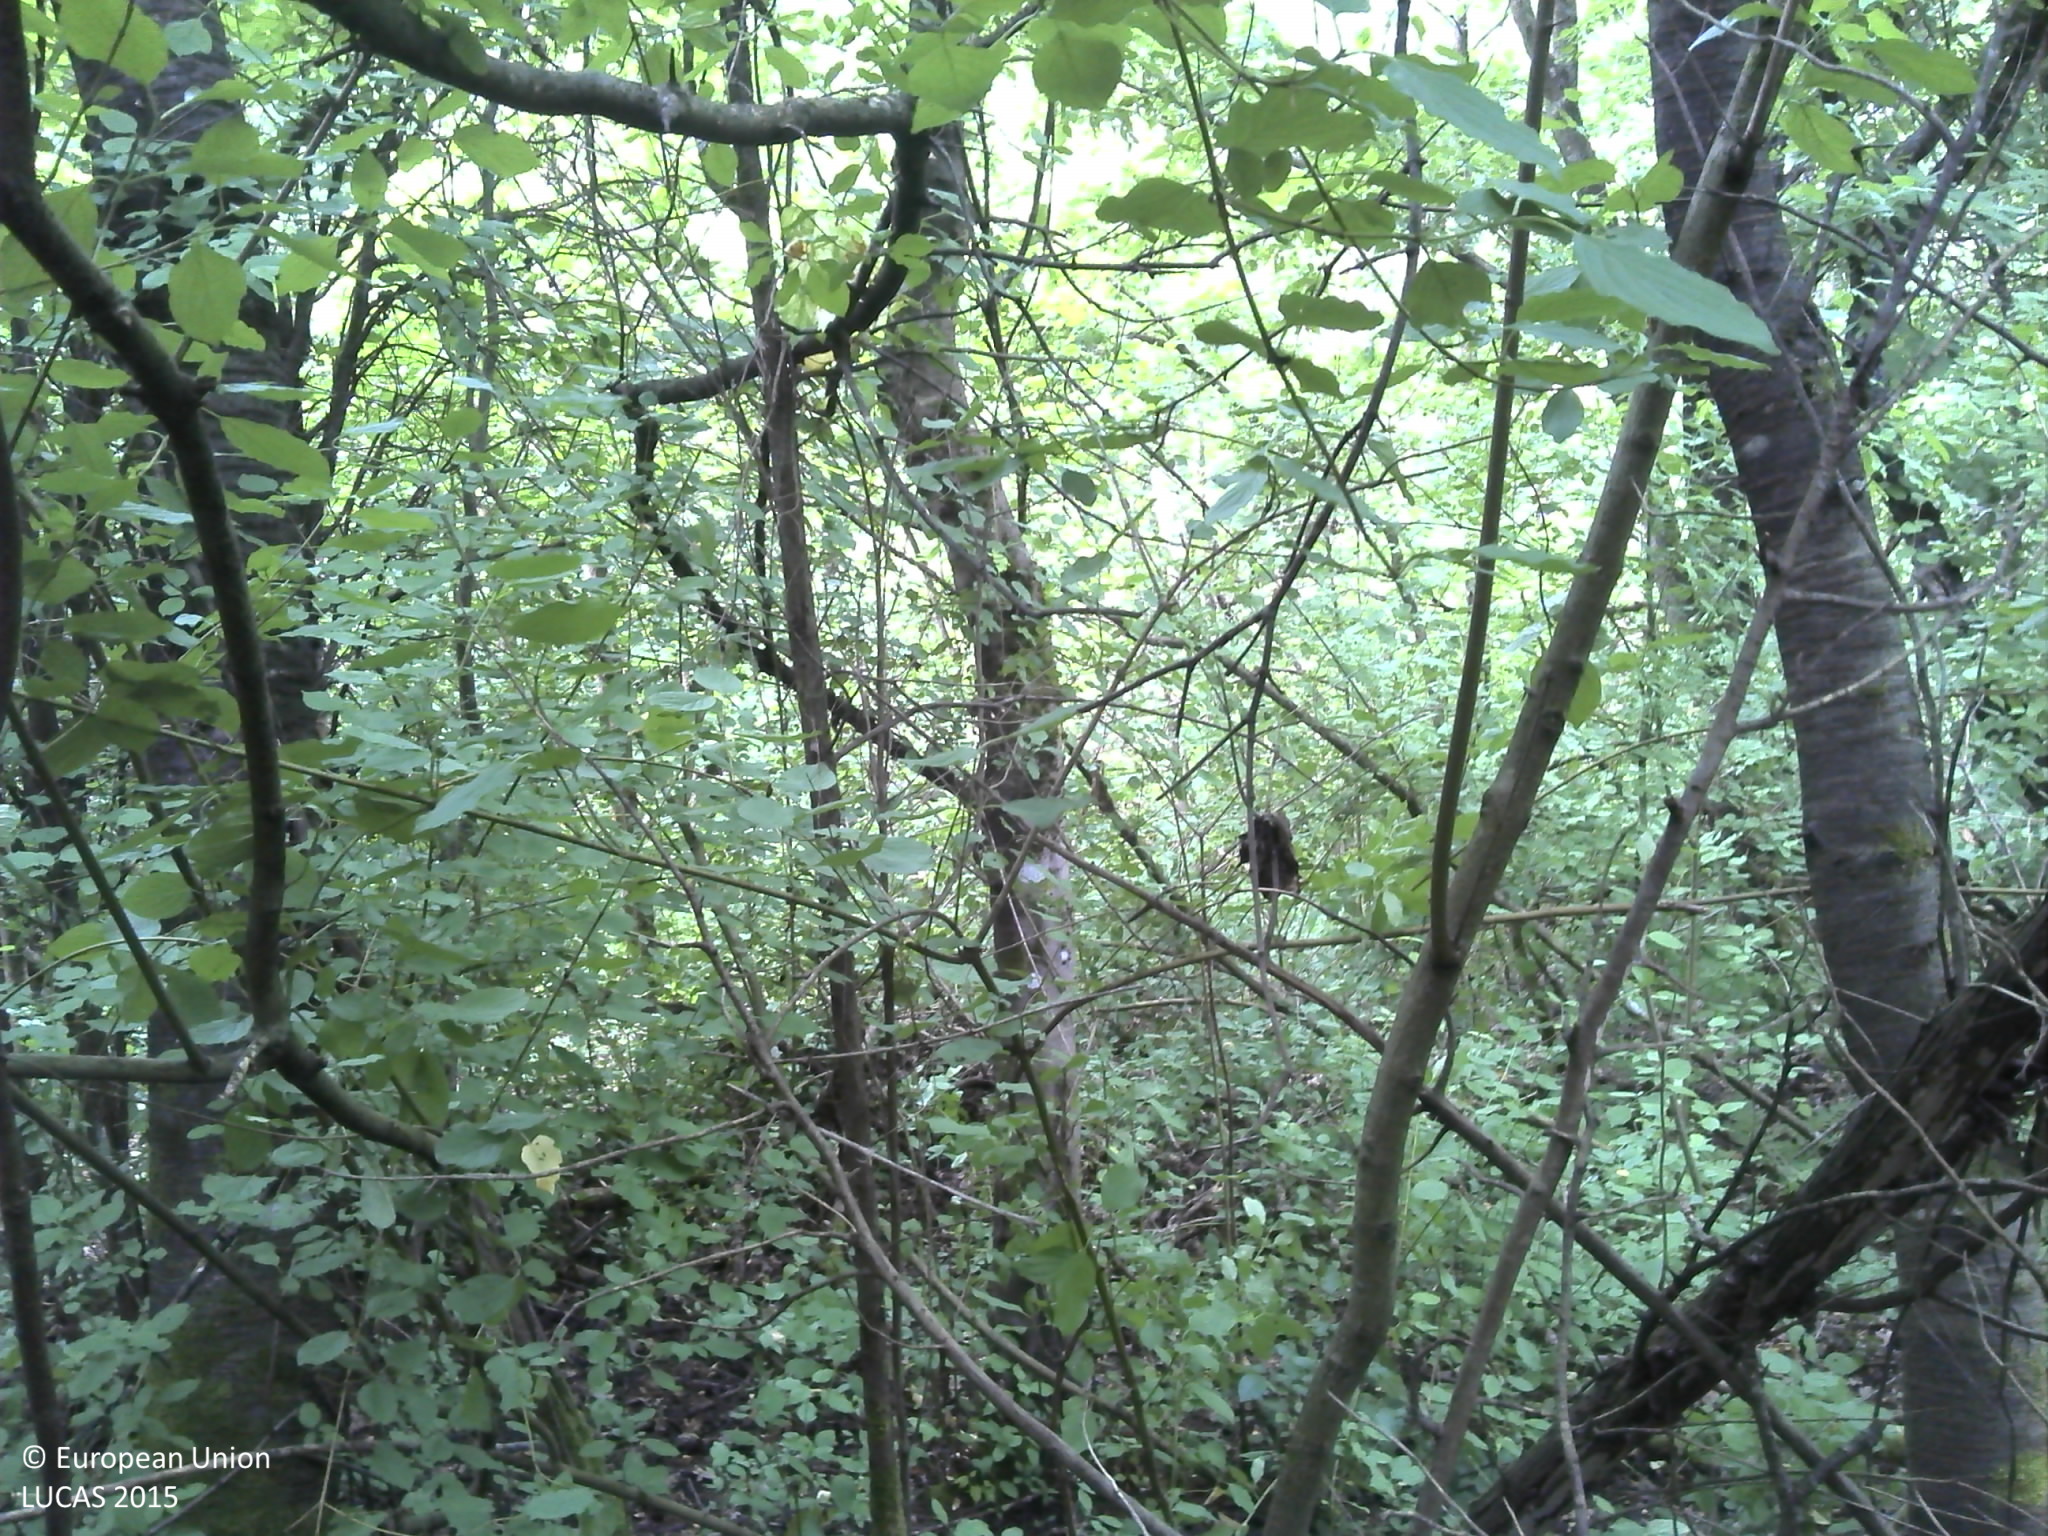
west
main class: Woodland
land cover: Broadleaved woodland
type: beech forest
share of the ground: > 75 %
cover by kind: broadleaved forest trees 100 %
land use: Forestry
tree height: > 5 m
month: June
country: HR
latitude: 45.3841
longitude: 17.4723
